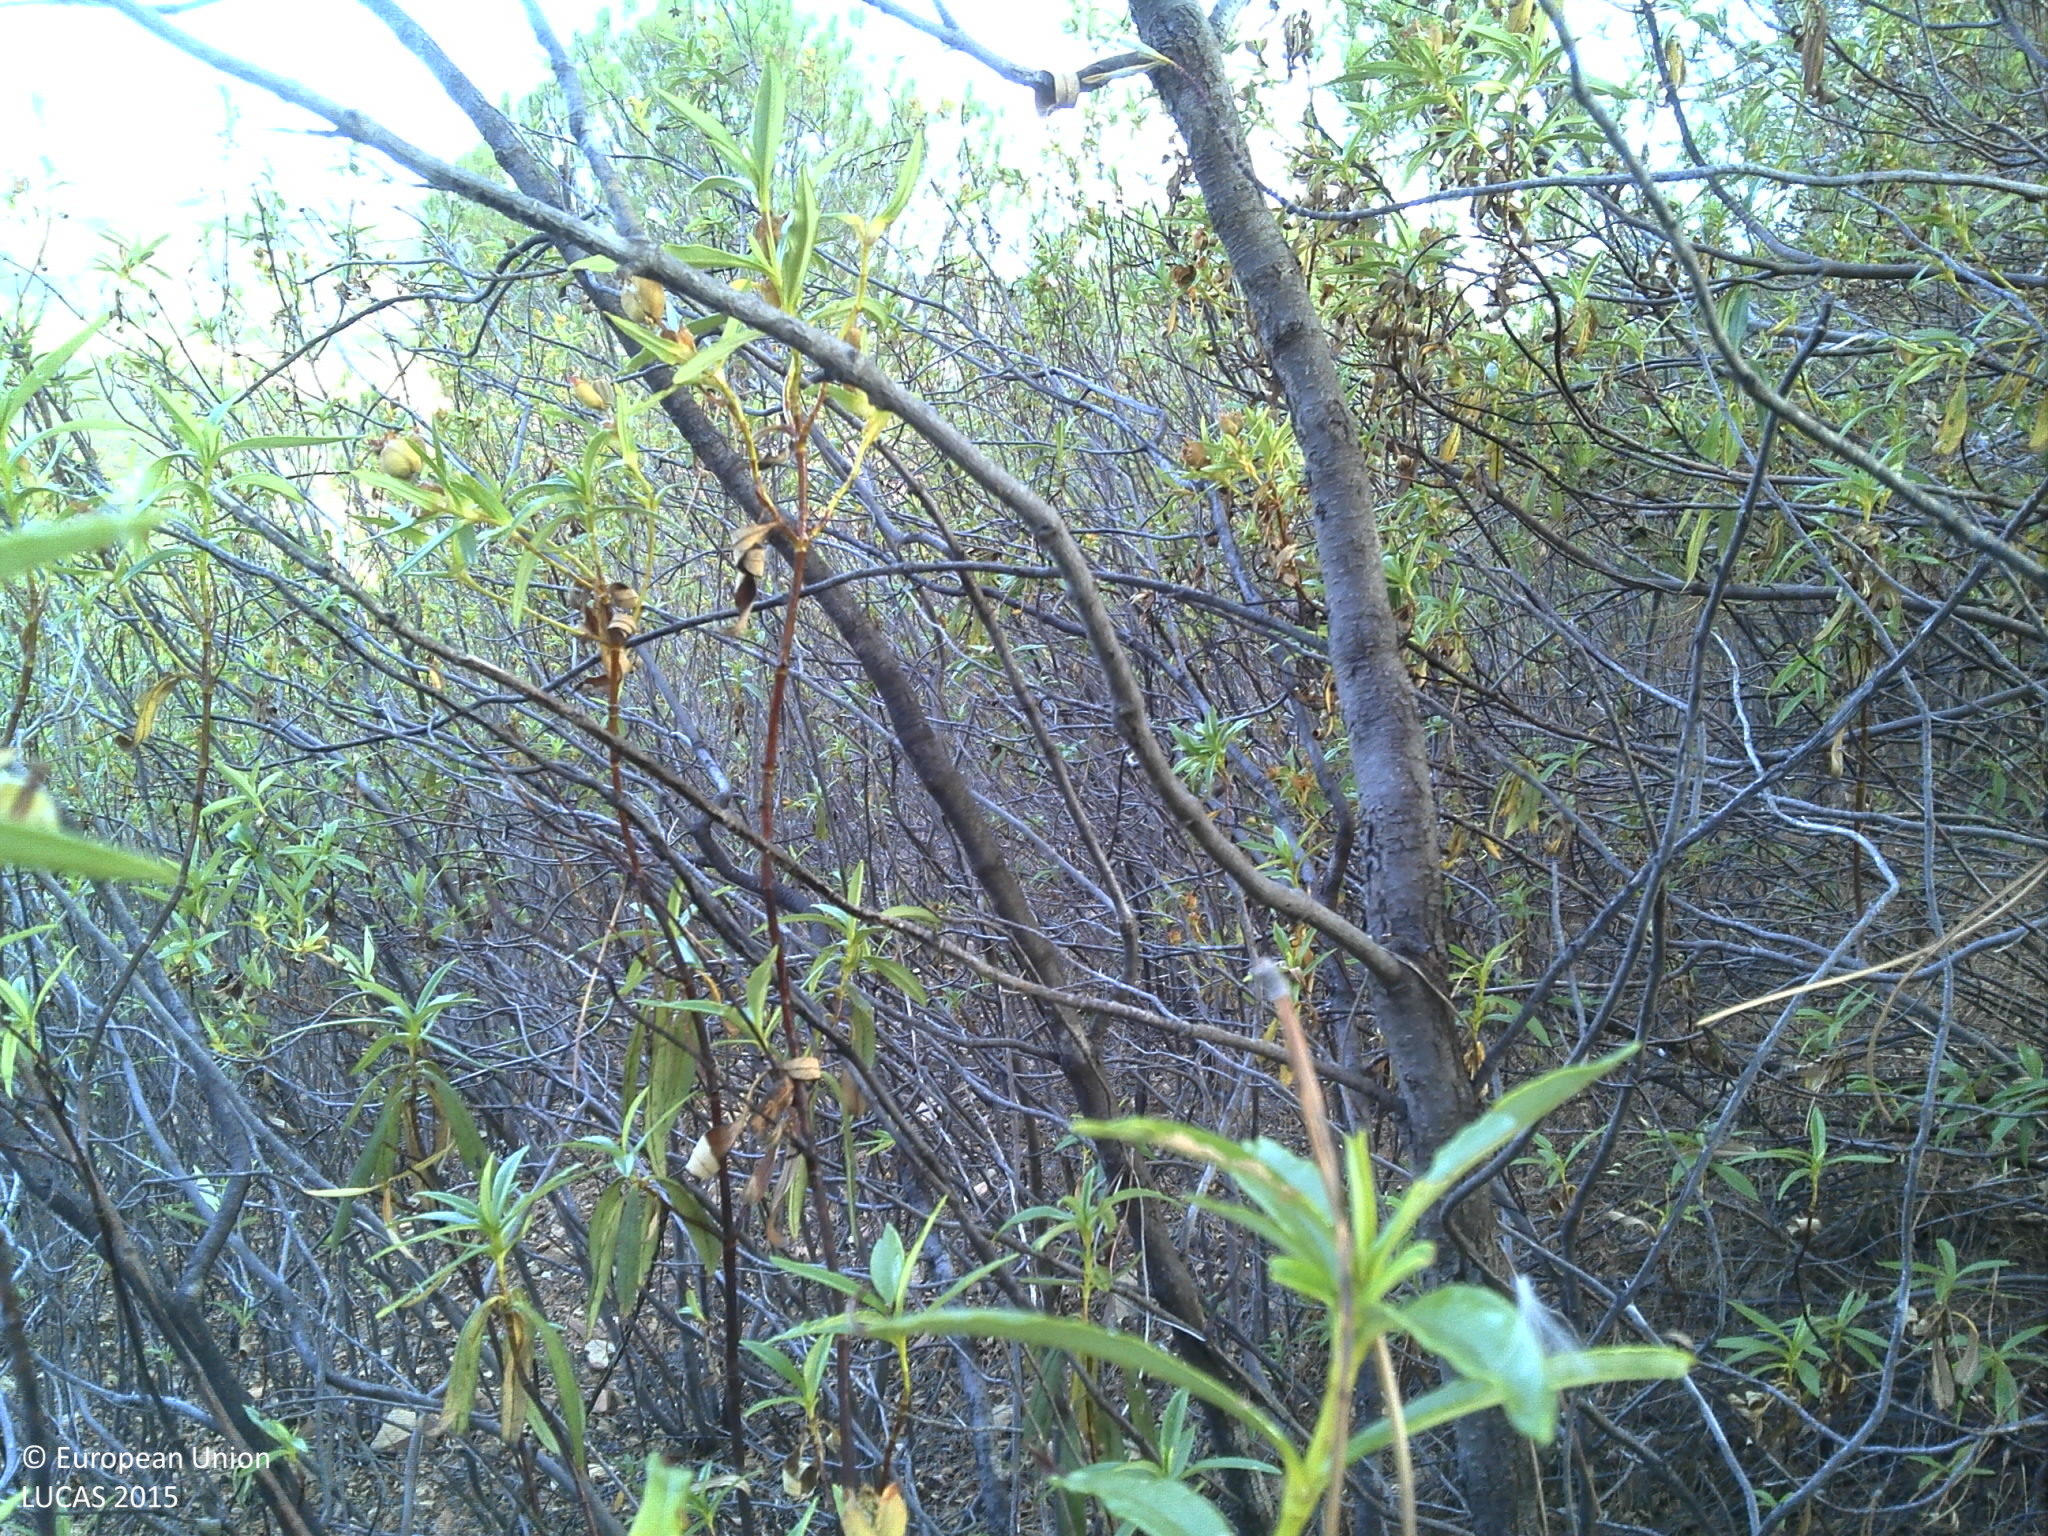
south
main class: Woodland
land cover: Pine dominated coniferous woodland
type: coniferous forest of the mediterranean region
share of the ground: 10 - 25 %
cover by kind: shrubs 90 %, coniferous forest trees 10 %
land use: Forestry
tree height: > 5 m
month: June
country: PT
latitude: 37.3454
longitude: -7.7222
